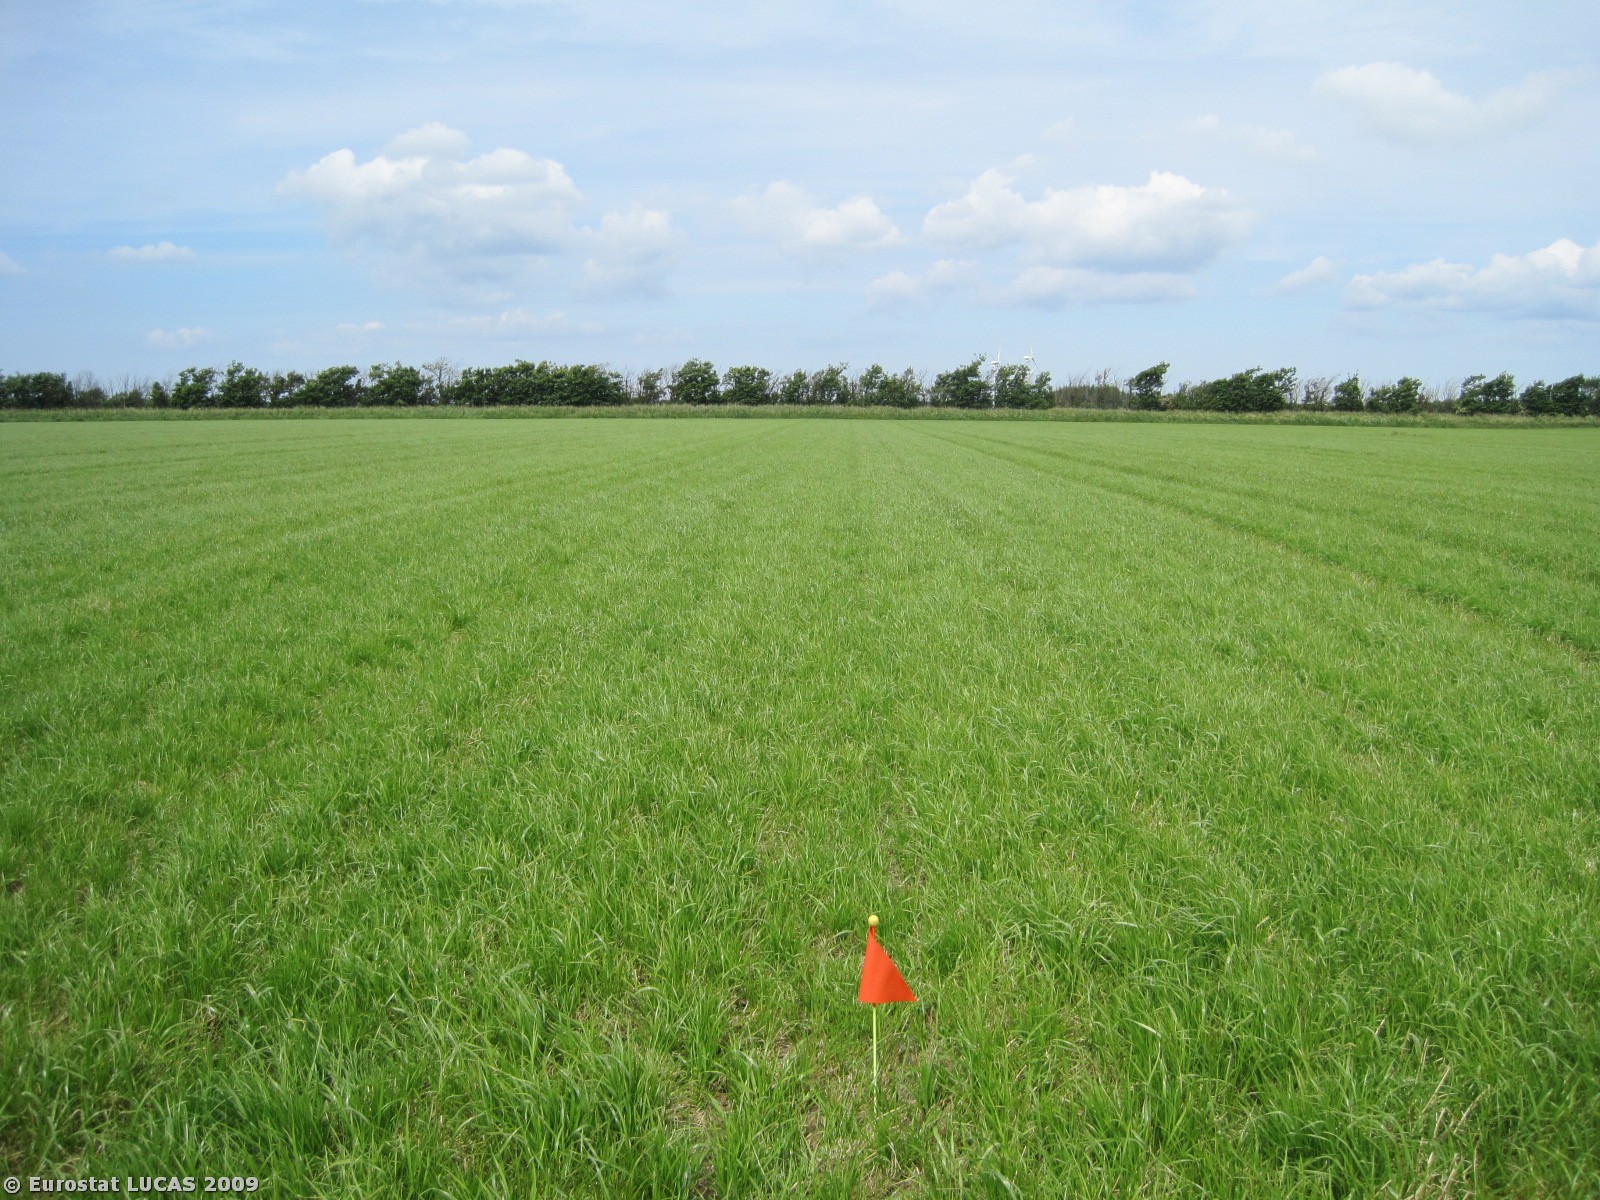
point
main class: Cropland
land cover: Temporary grasslands
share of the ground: > 75 %
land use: Agriculture (excluding fallow land and kitchen gardens)
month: June
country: DK
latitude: 57.3201
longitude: 9.7513
